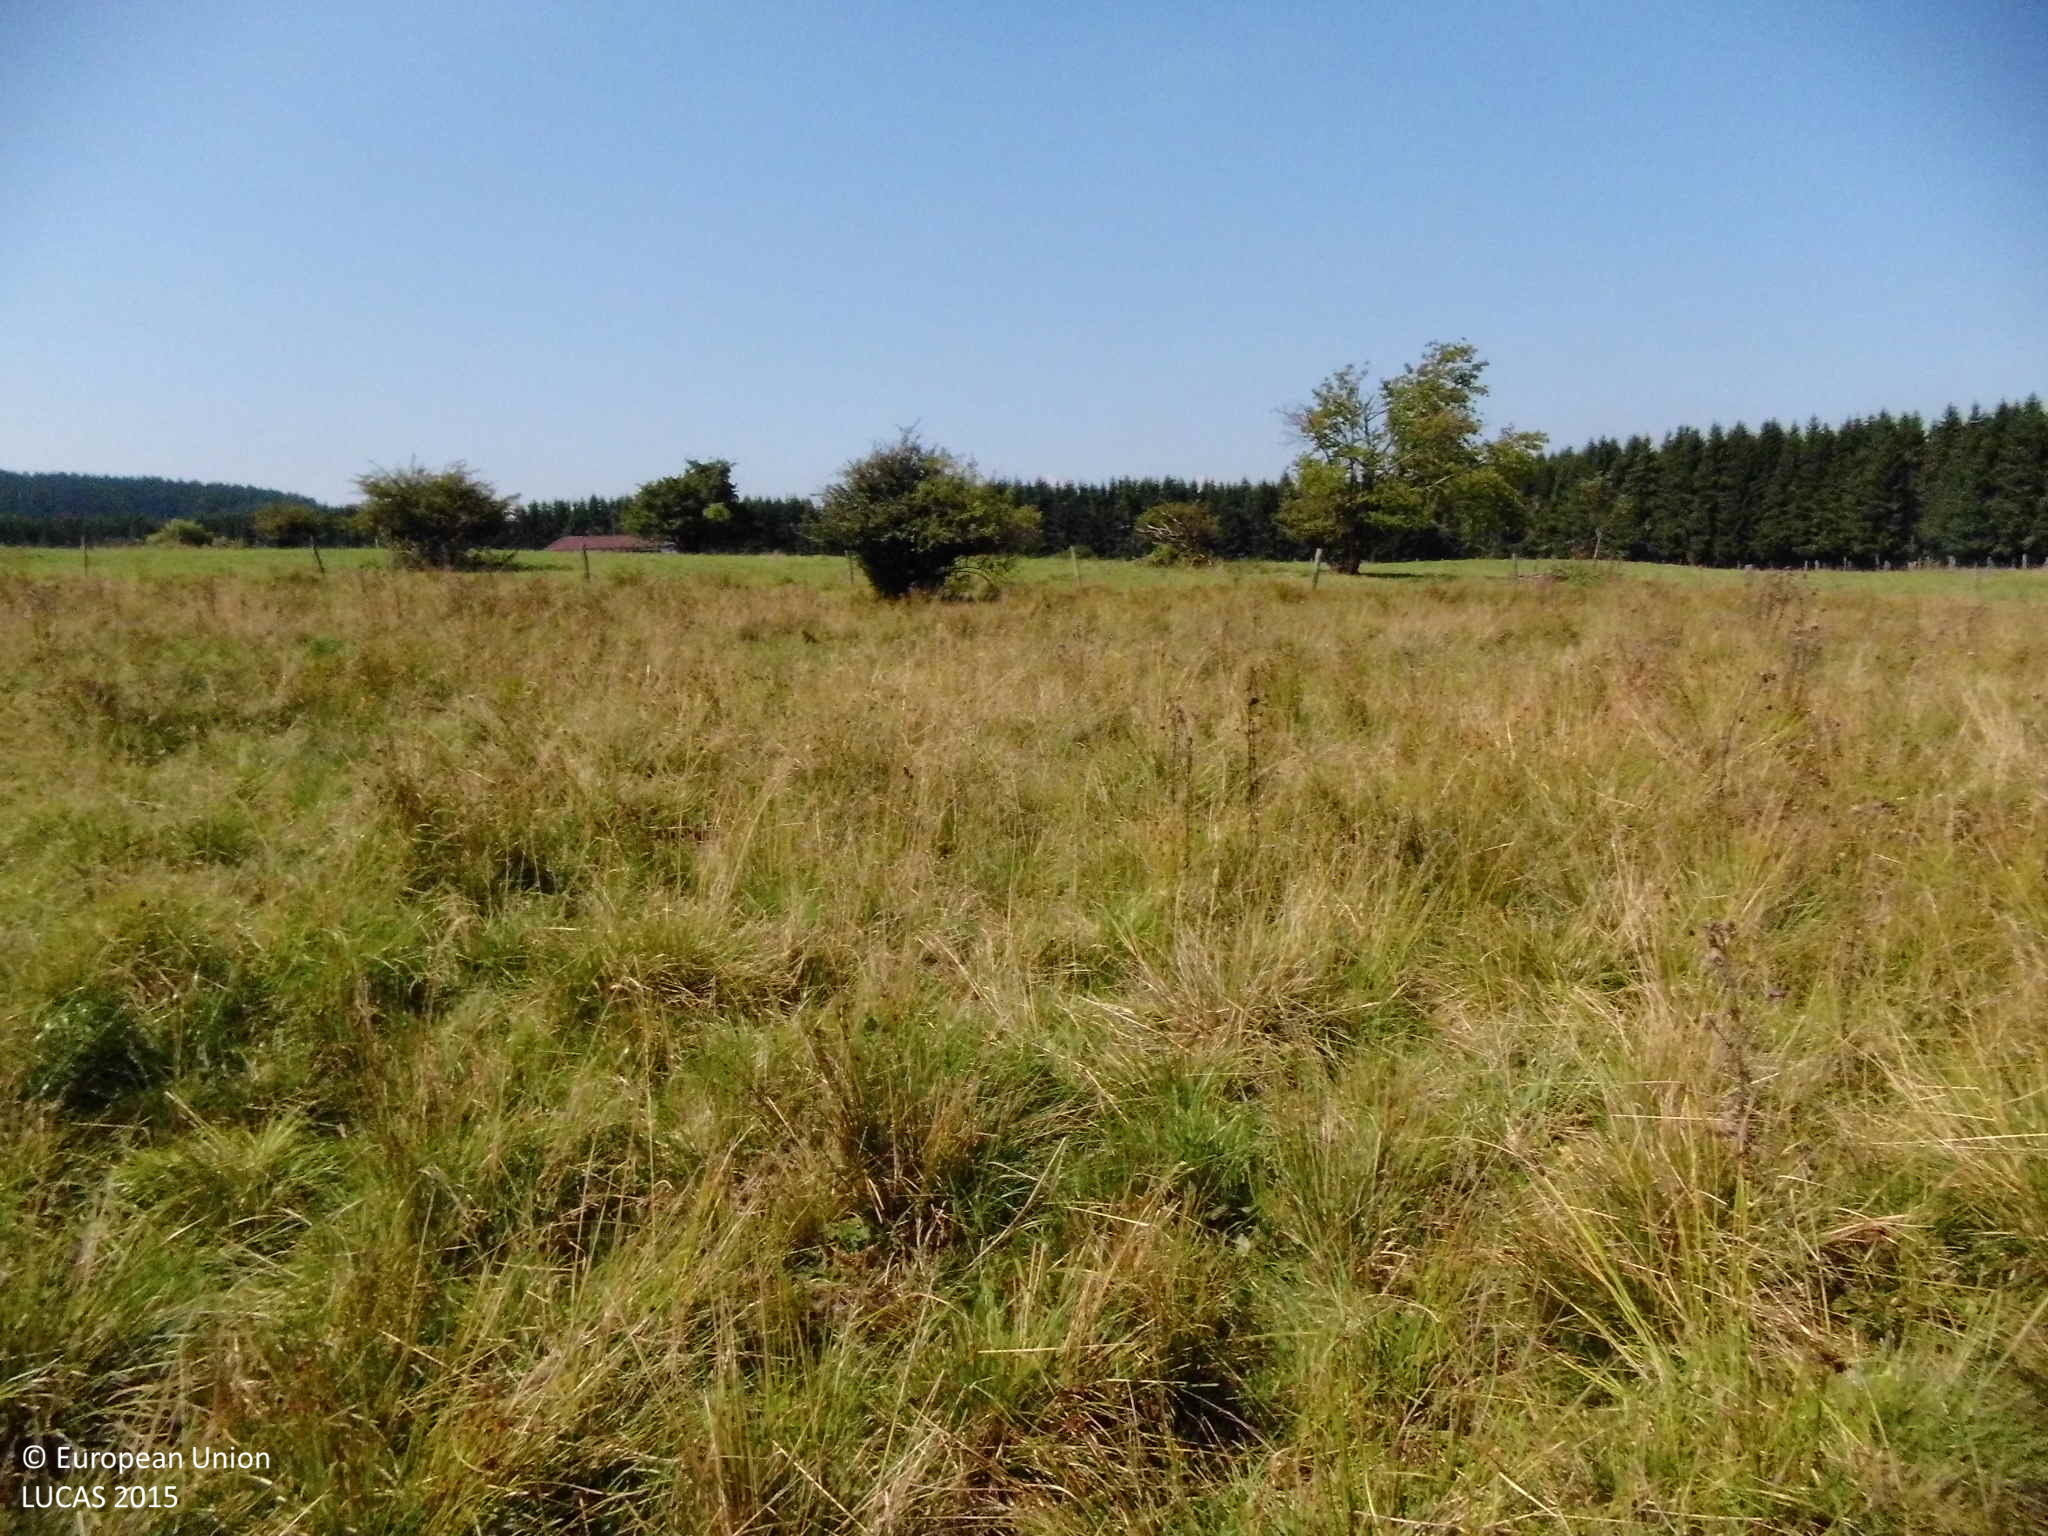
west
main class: Grassland
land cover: Spontaneously vegetated surfaces
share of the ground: > 75 %
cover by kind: herbaceous plants 95 %, shrubs 5 %
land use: Fallow land
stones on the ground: < 10 %
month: August
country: DE
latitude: 50.6723
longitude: 8.1184
